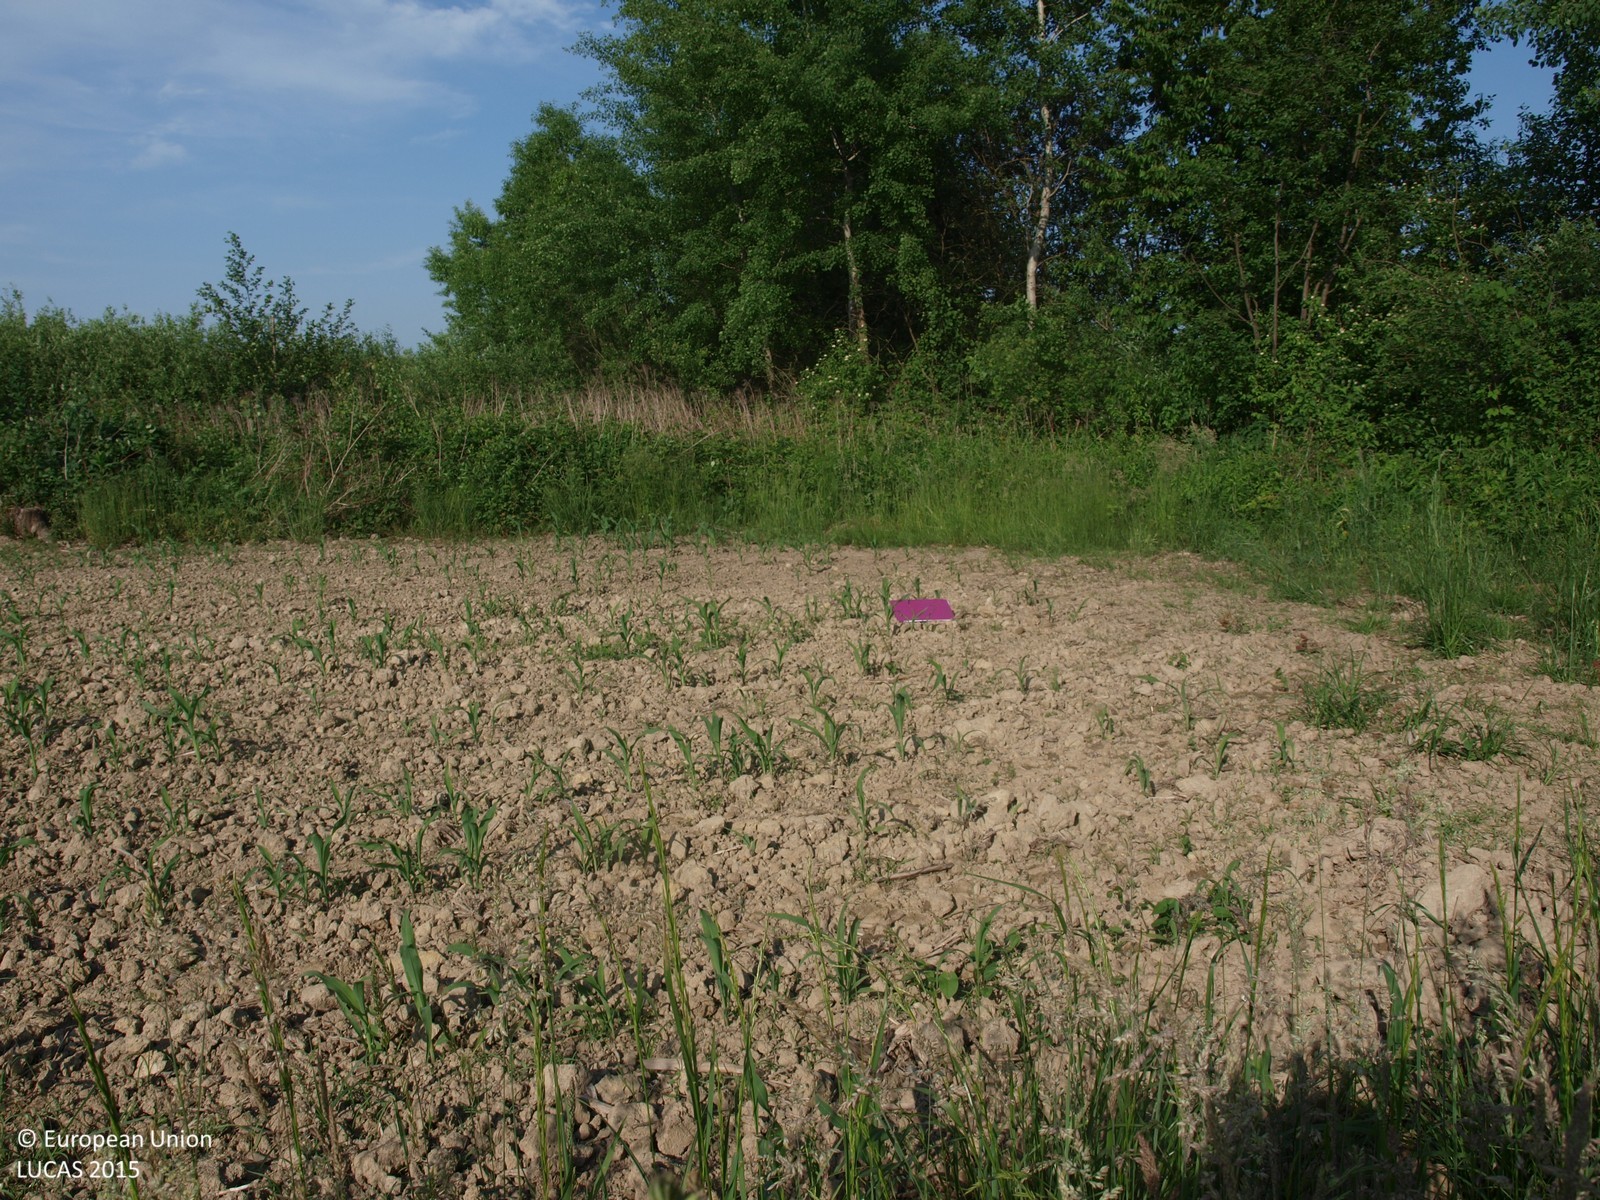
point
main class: Cropland
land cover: Maize
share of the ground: 25 - 50 %
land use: Agriculture (excluding fallow land and kitchen gardens)
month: May
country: HR
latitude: 46.2608
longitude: 16.2140
